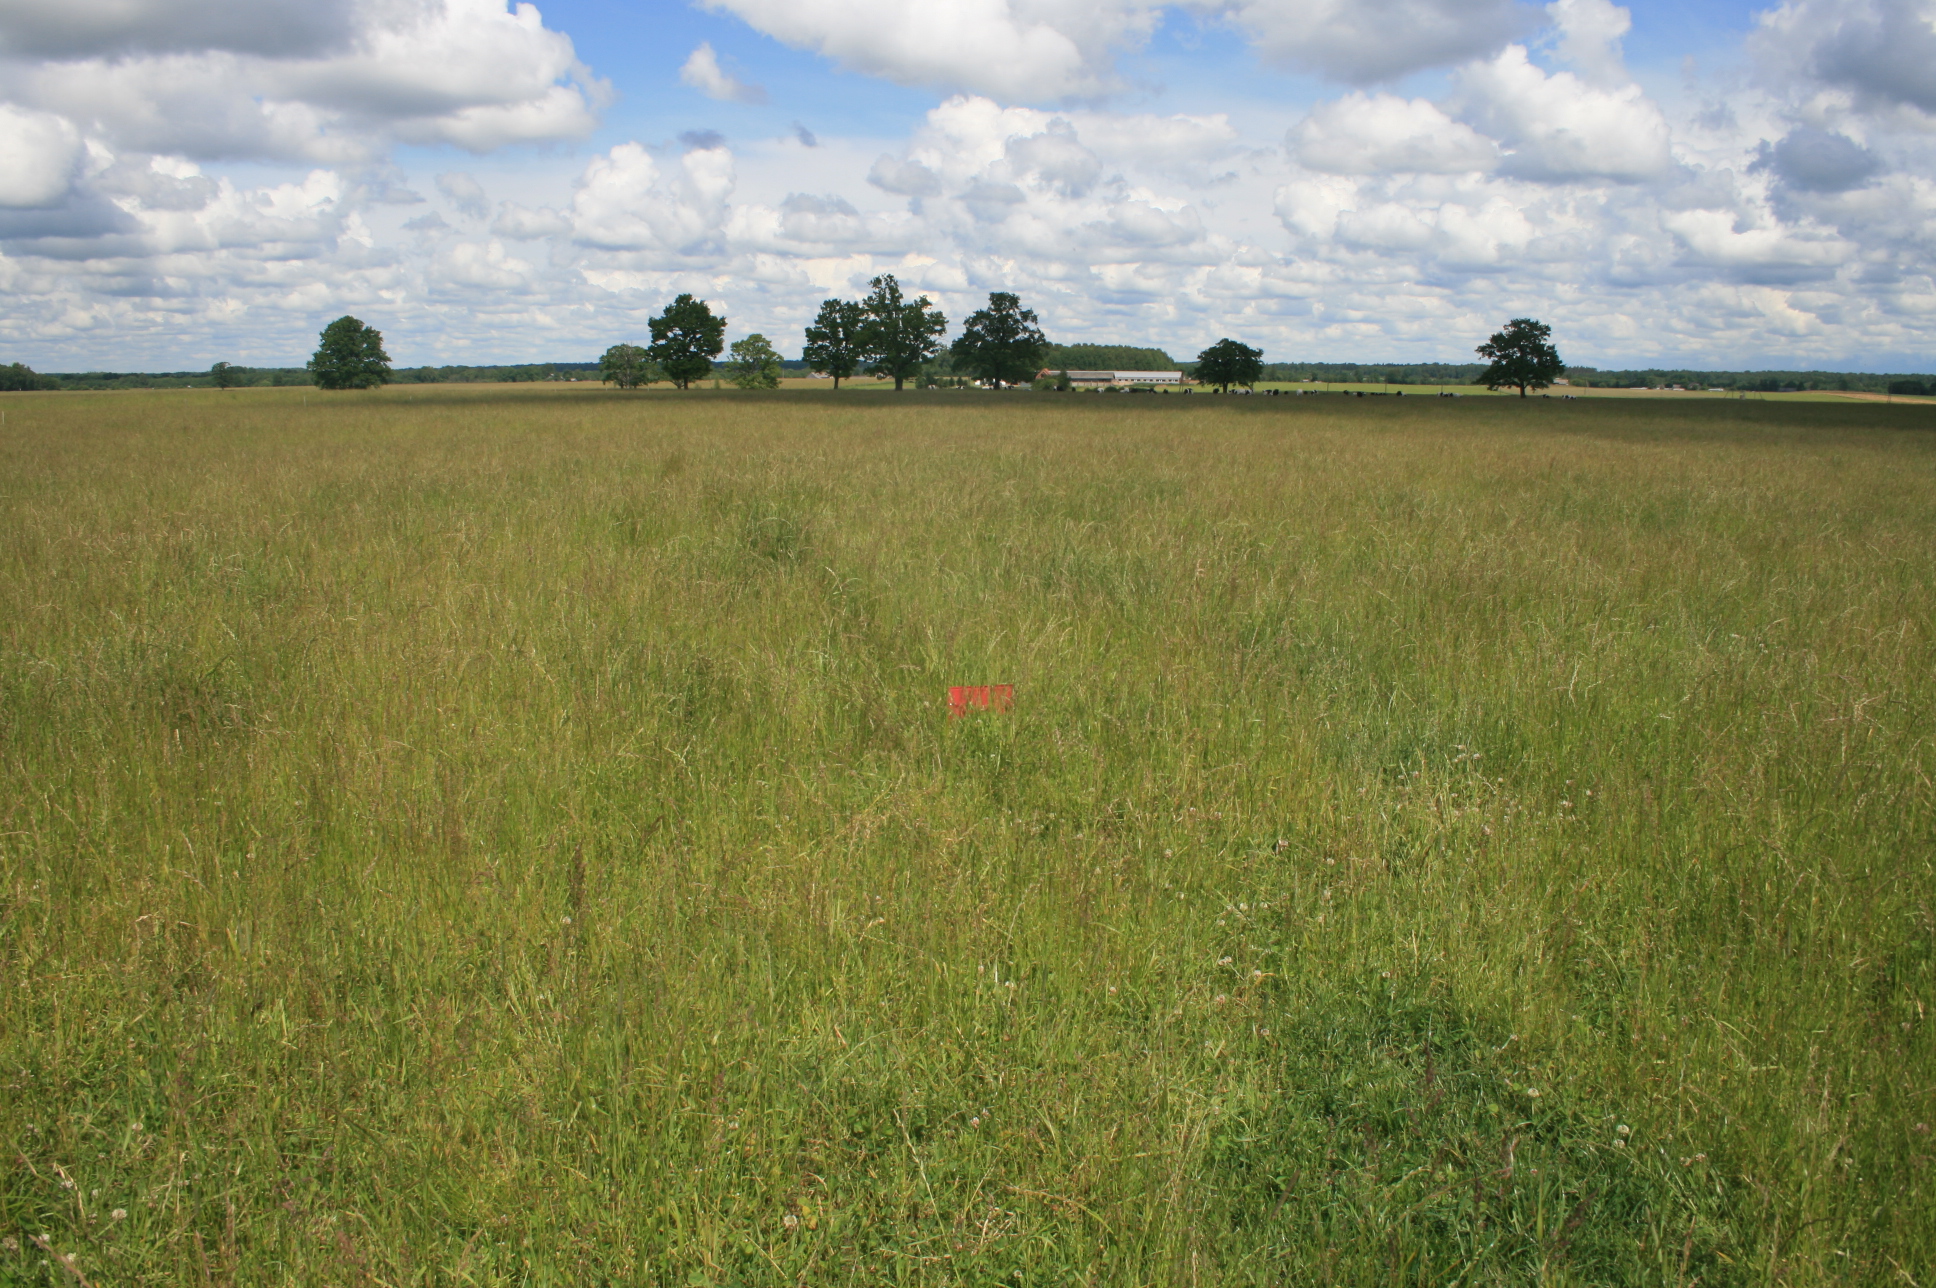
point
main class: Grassland
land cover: Grassland without tree/shrub cover
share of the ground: > 75 %
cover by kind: herbaceous plants 100 %
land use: Agriculture (excluding fallow land and kitchen gardens)
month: June
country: LT
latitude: 55.2703
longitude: 22.0637
